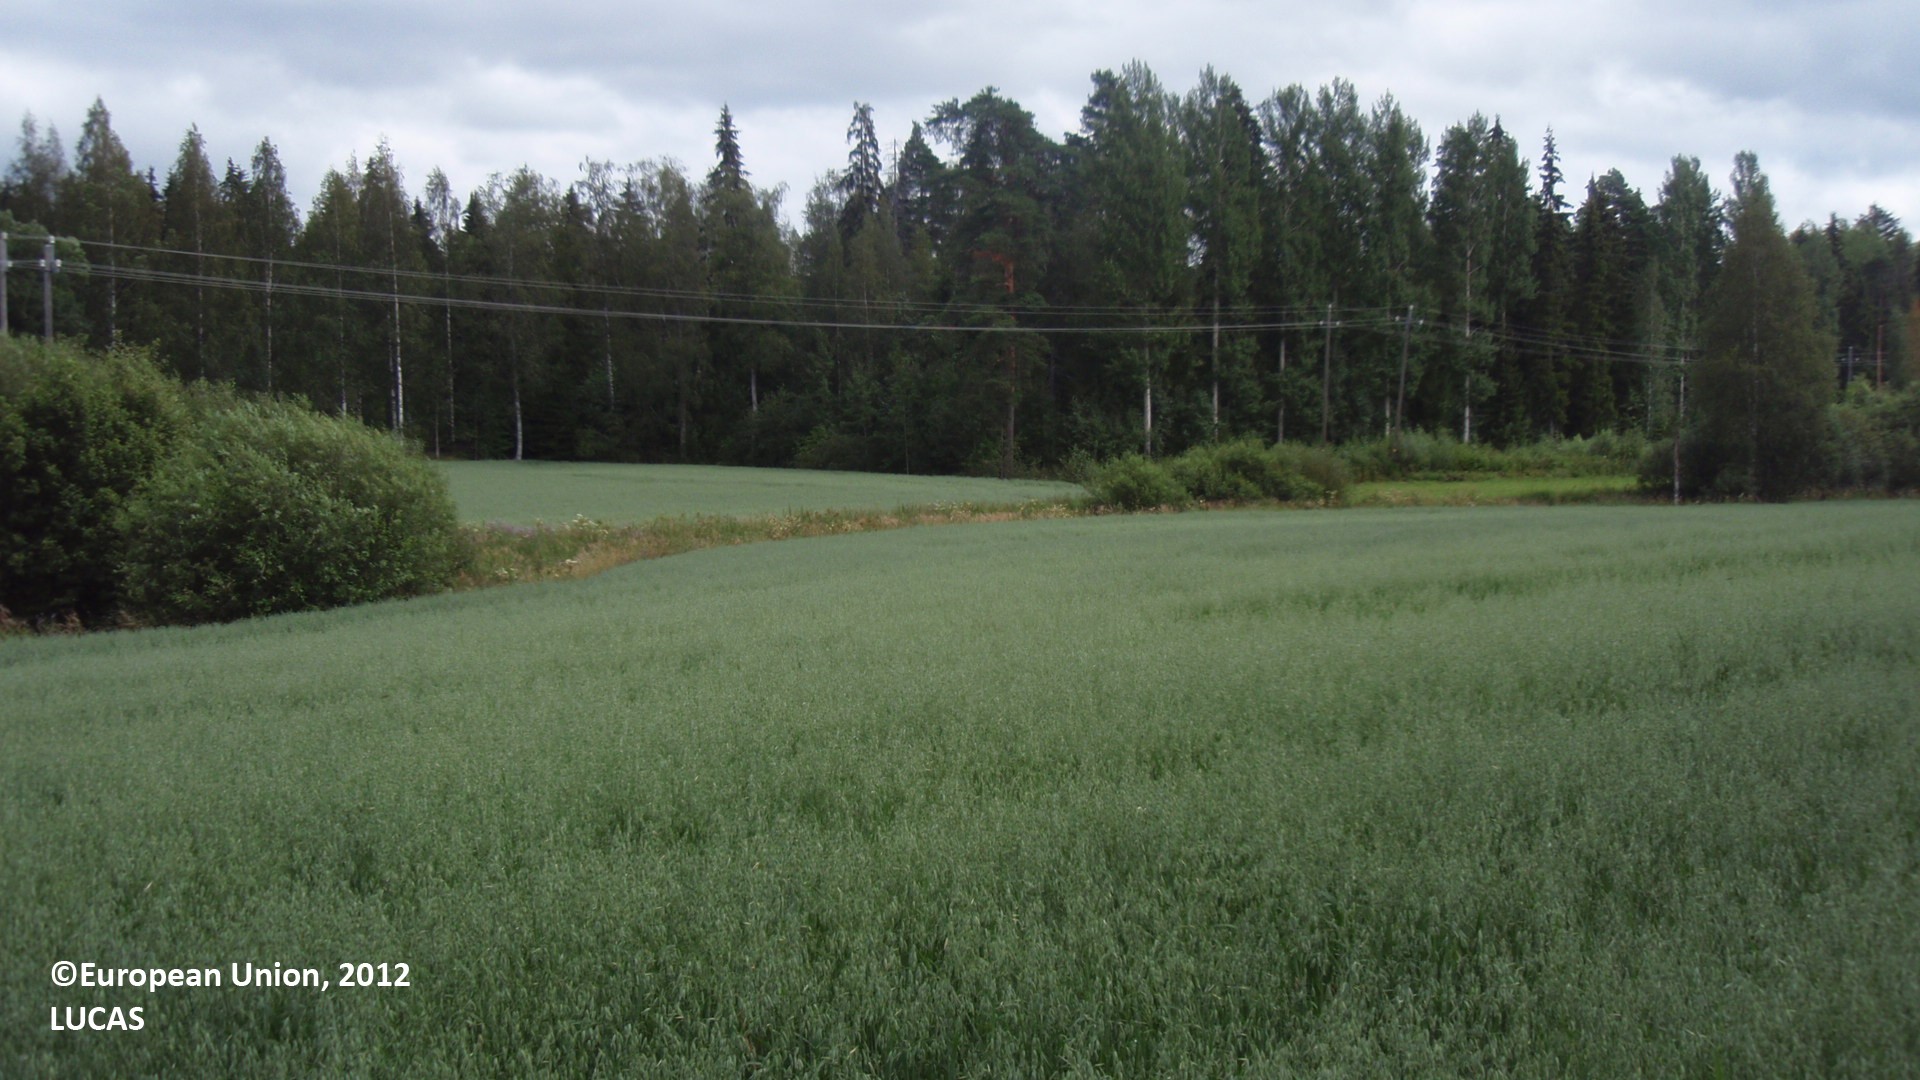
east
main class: Cropland
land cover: Oats
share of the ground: > 75 %
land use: Agriculture (excluding fallow land and kitchen gardens)
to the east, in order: Lines of trees; Grass margins; Oats; Grass margins; Ditches and canals; Grassland without tree/shrub cover; Broadleaved woodland; Inland running water; Grass margins; Spruce dominated mixed woodland
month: July
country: FI
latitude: 61.0059
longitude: 28.4694
